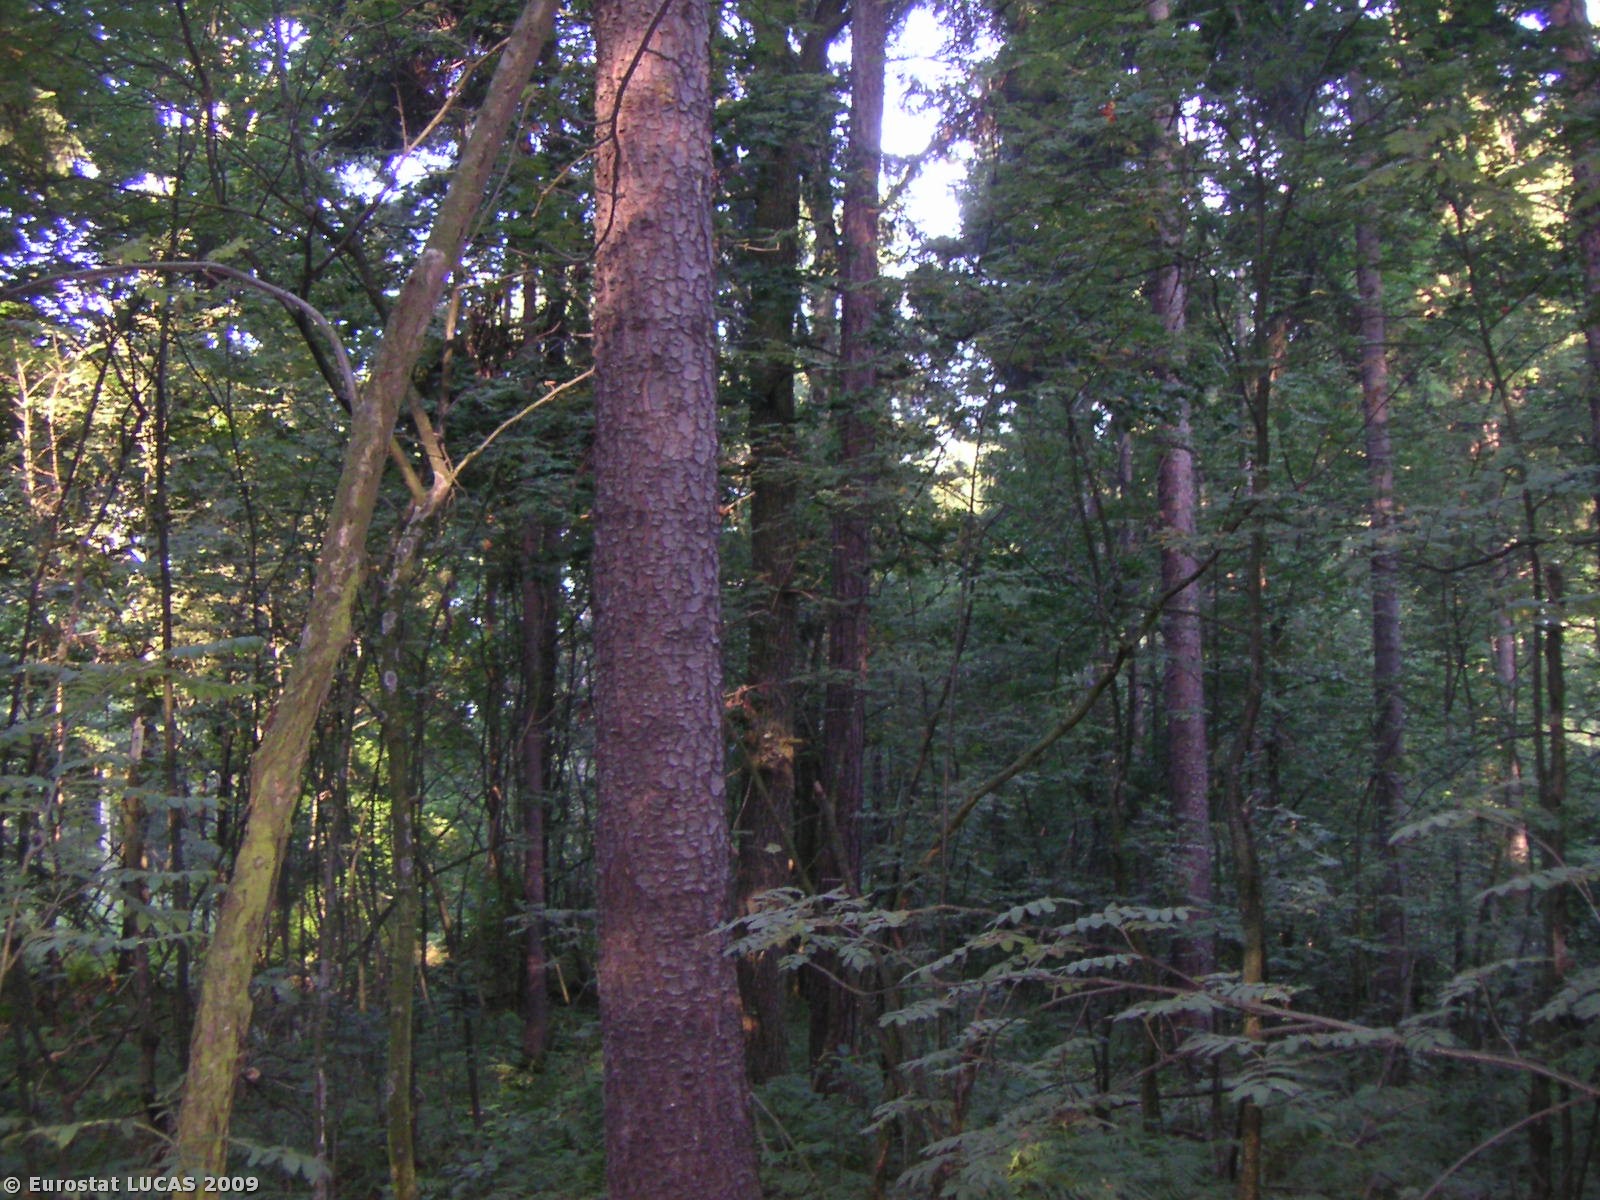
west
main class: Woodland
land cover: Mixed woodland
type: hemiboreal forest and nemoral coniferous forest and mixed broadleaved-coniferous forest
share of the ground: > 75 %
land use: Nature reserves
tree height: > 5 m
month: August
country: PL
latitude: 50.3831
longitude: 18.8396
